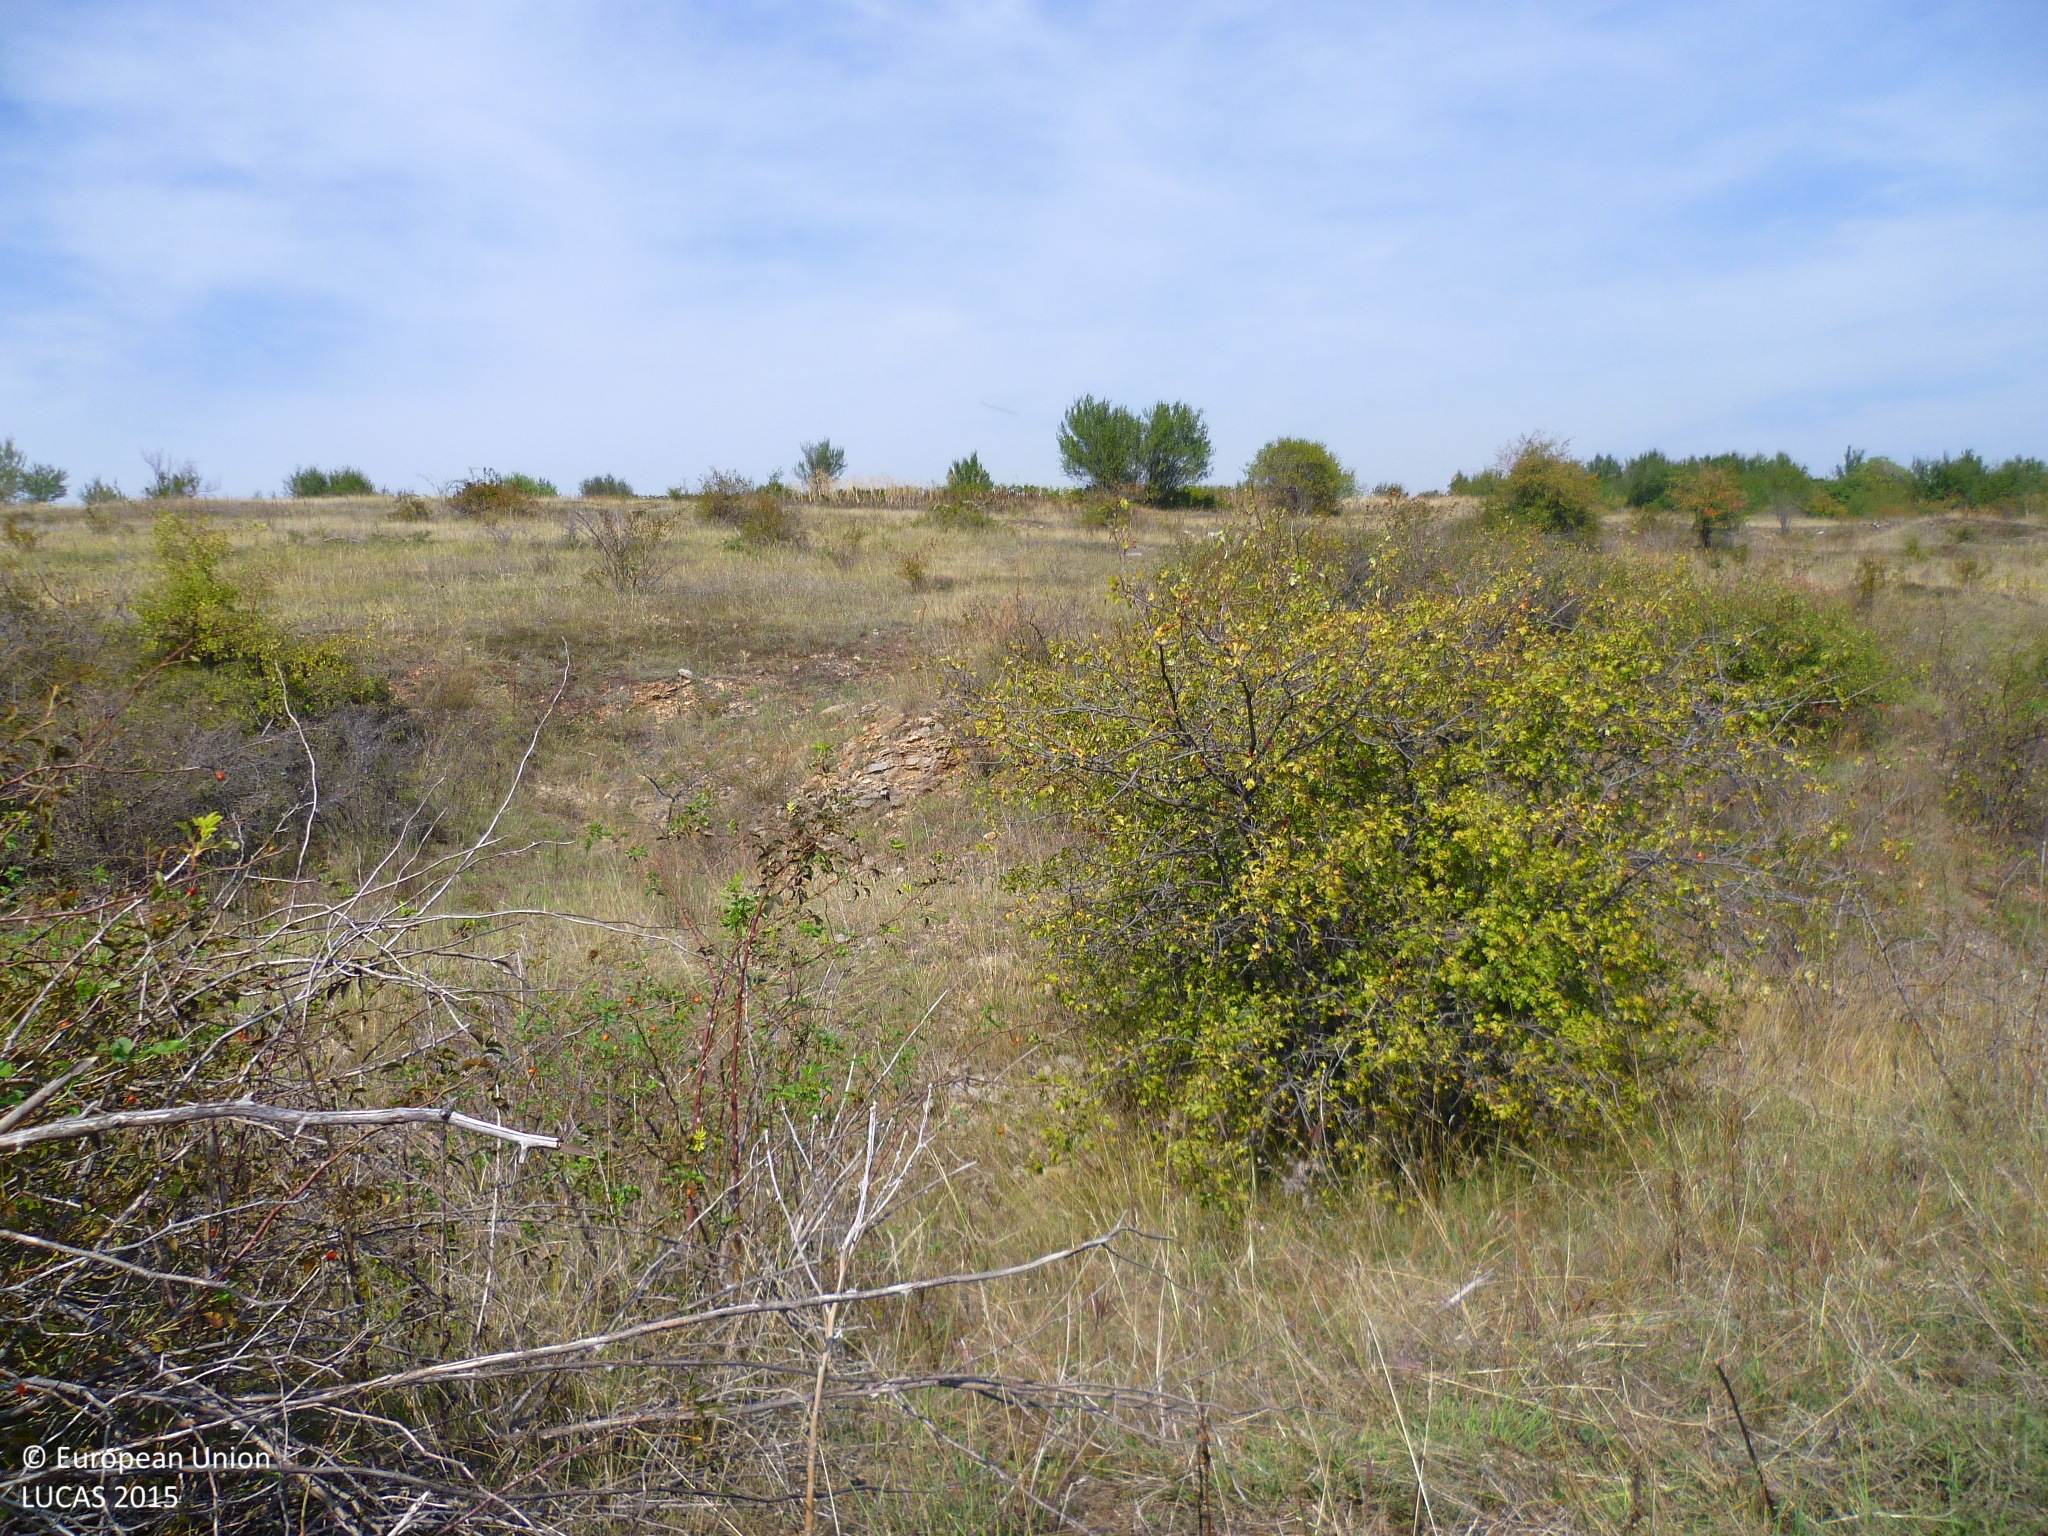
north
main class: Grassland
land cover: Grassland with sparse tree/shrub cover
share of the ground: > 75 %
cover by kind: herbaceous plants 90 %, broadleaved forest trees 5 %, shrubs 5 %
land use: Agriculture (excluding fallow land and kitchen gardens)
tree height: < 5 m
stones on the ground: 10 - 25 %
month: September
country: BG
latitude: 42.8598
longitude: 23.0915
